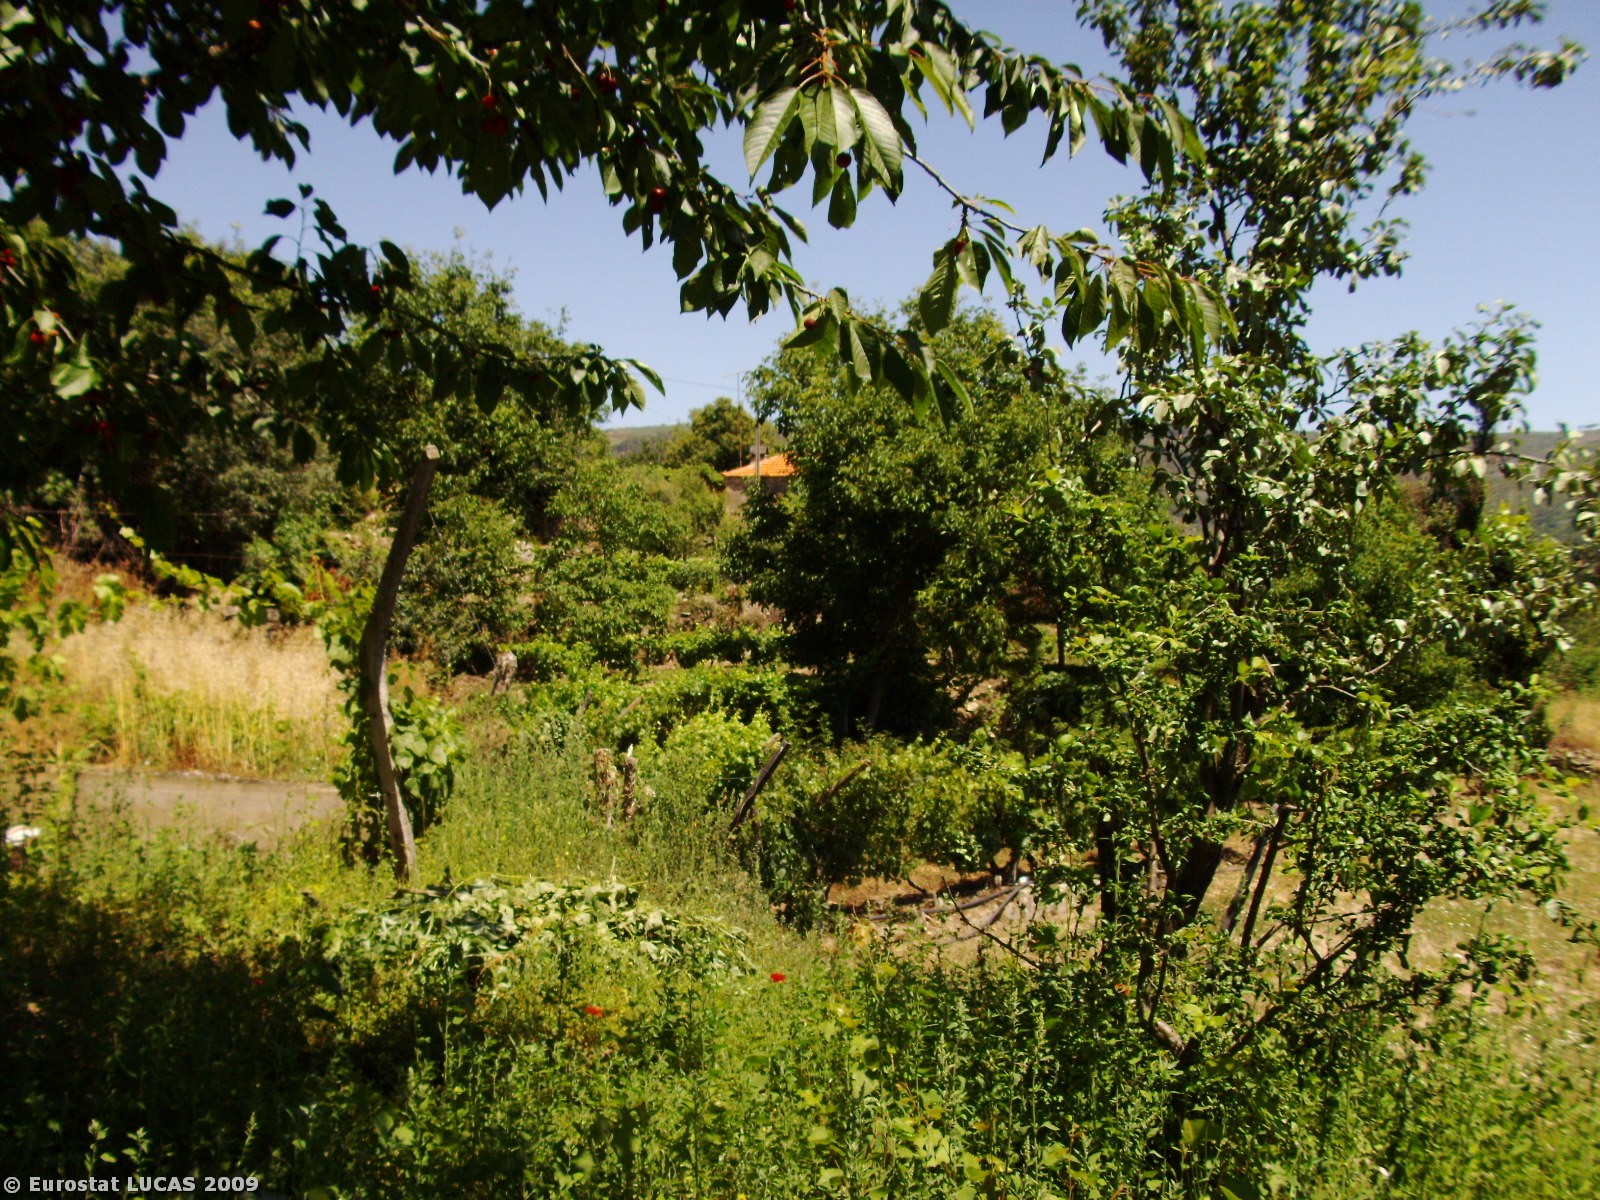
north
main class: Cropland
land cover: Nuts trees
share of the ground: > 75 %
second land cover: Spontaneously vegetated surfaces
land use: Agriculture (excluding fallow land and kitchen gardens)
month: July
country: PT
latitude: 41.0533
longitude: -7.7477
